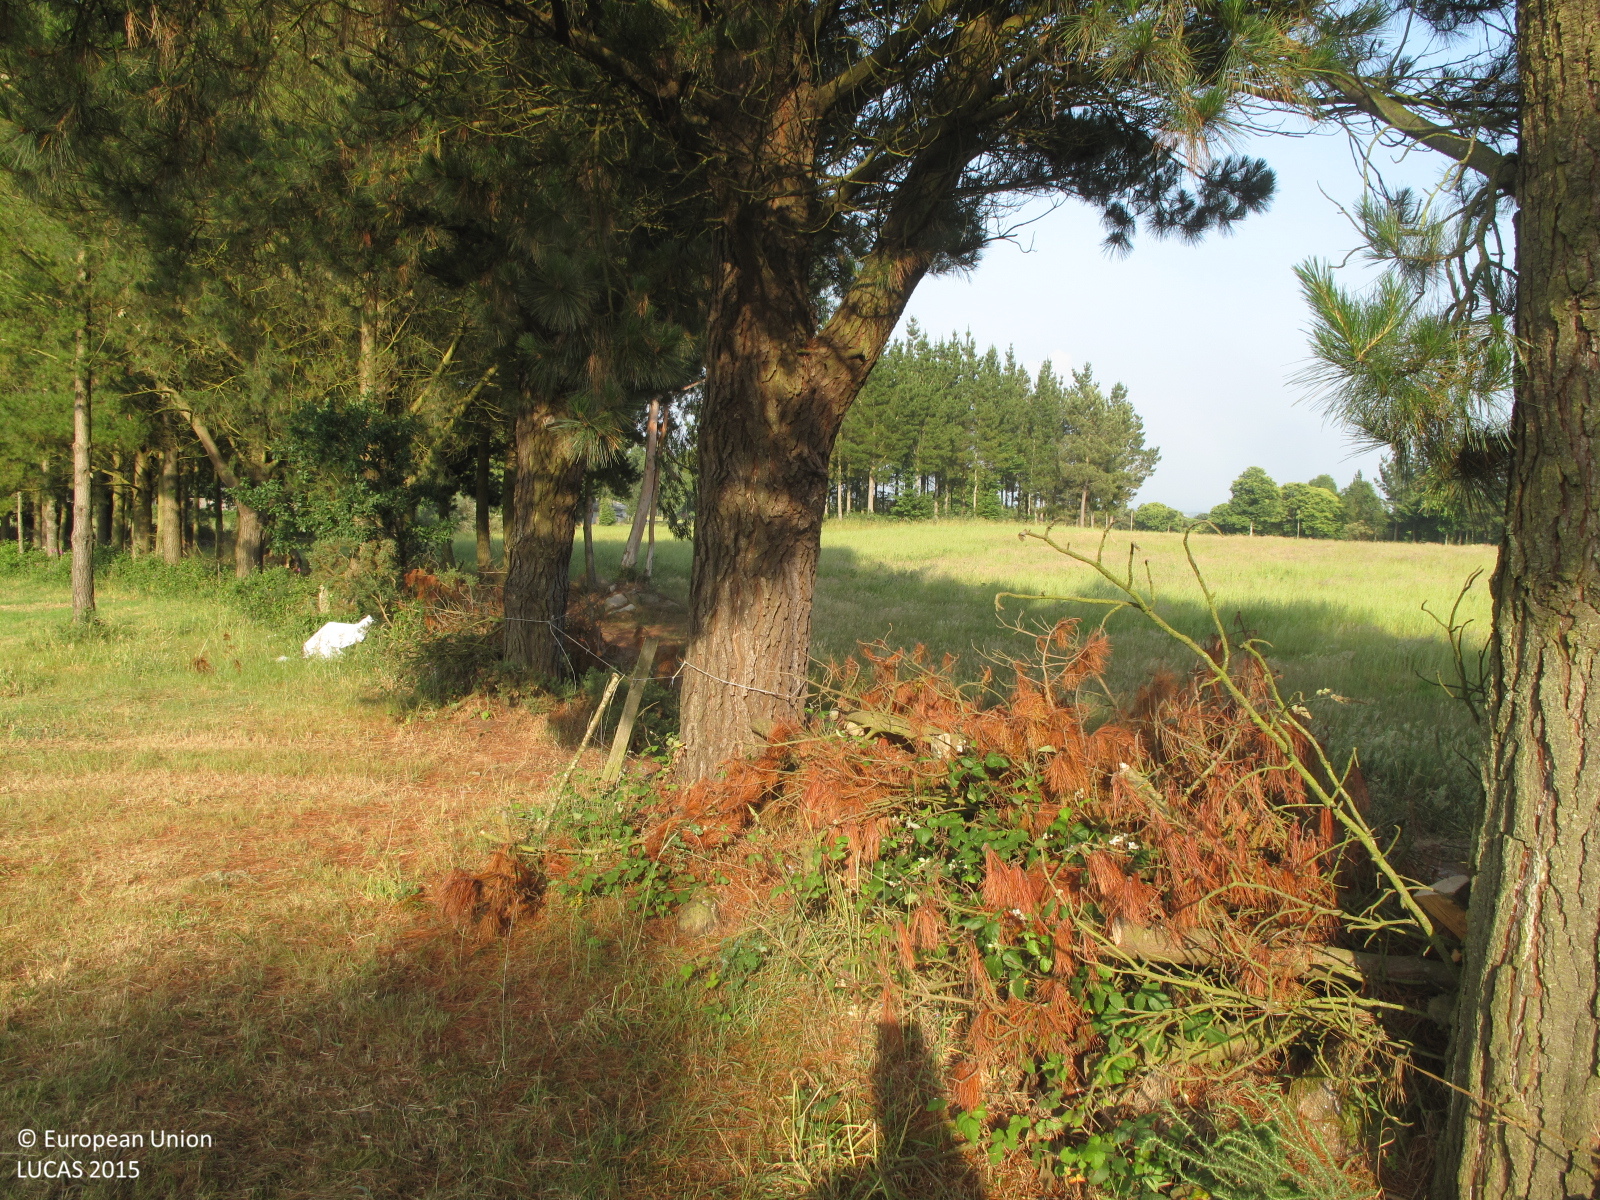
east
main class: Grassland
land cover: Grassland without tree/shrub cover
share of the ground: > 75 %
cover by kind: herbaceous plants 100 %
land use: Agriculture (excluding fallow land and kitchen gardens)
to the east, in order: Grassland without tree/shrub cover; Pine dominated coniferous woodland; Fences; Tracks; Grassland without tree/shrub cover
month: June
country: ES
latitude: 43.0764
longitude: -7.8839
